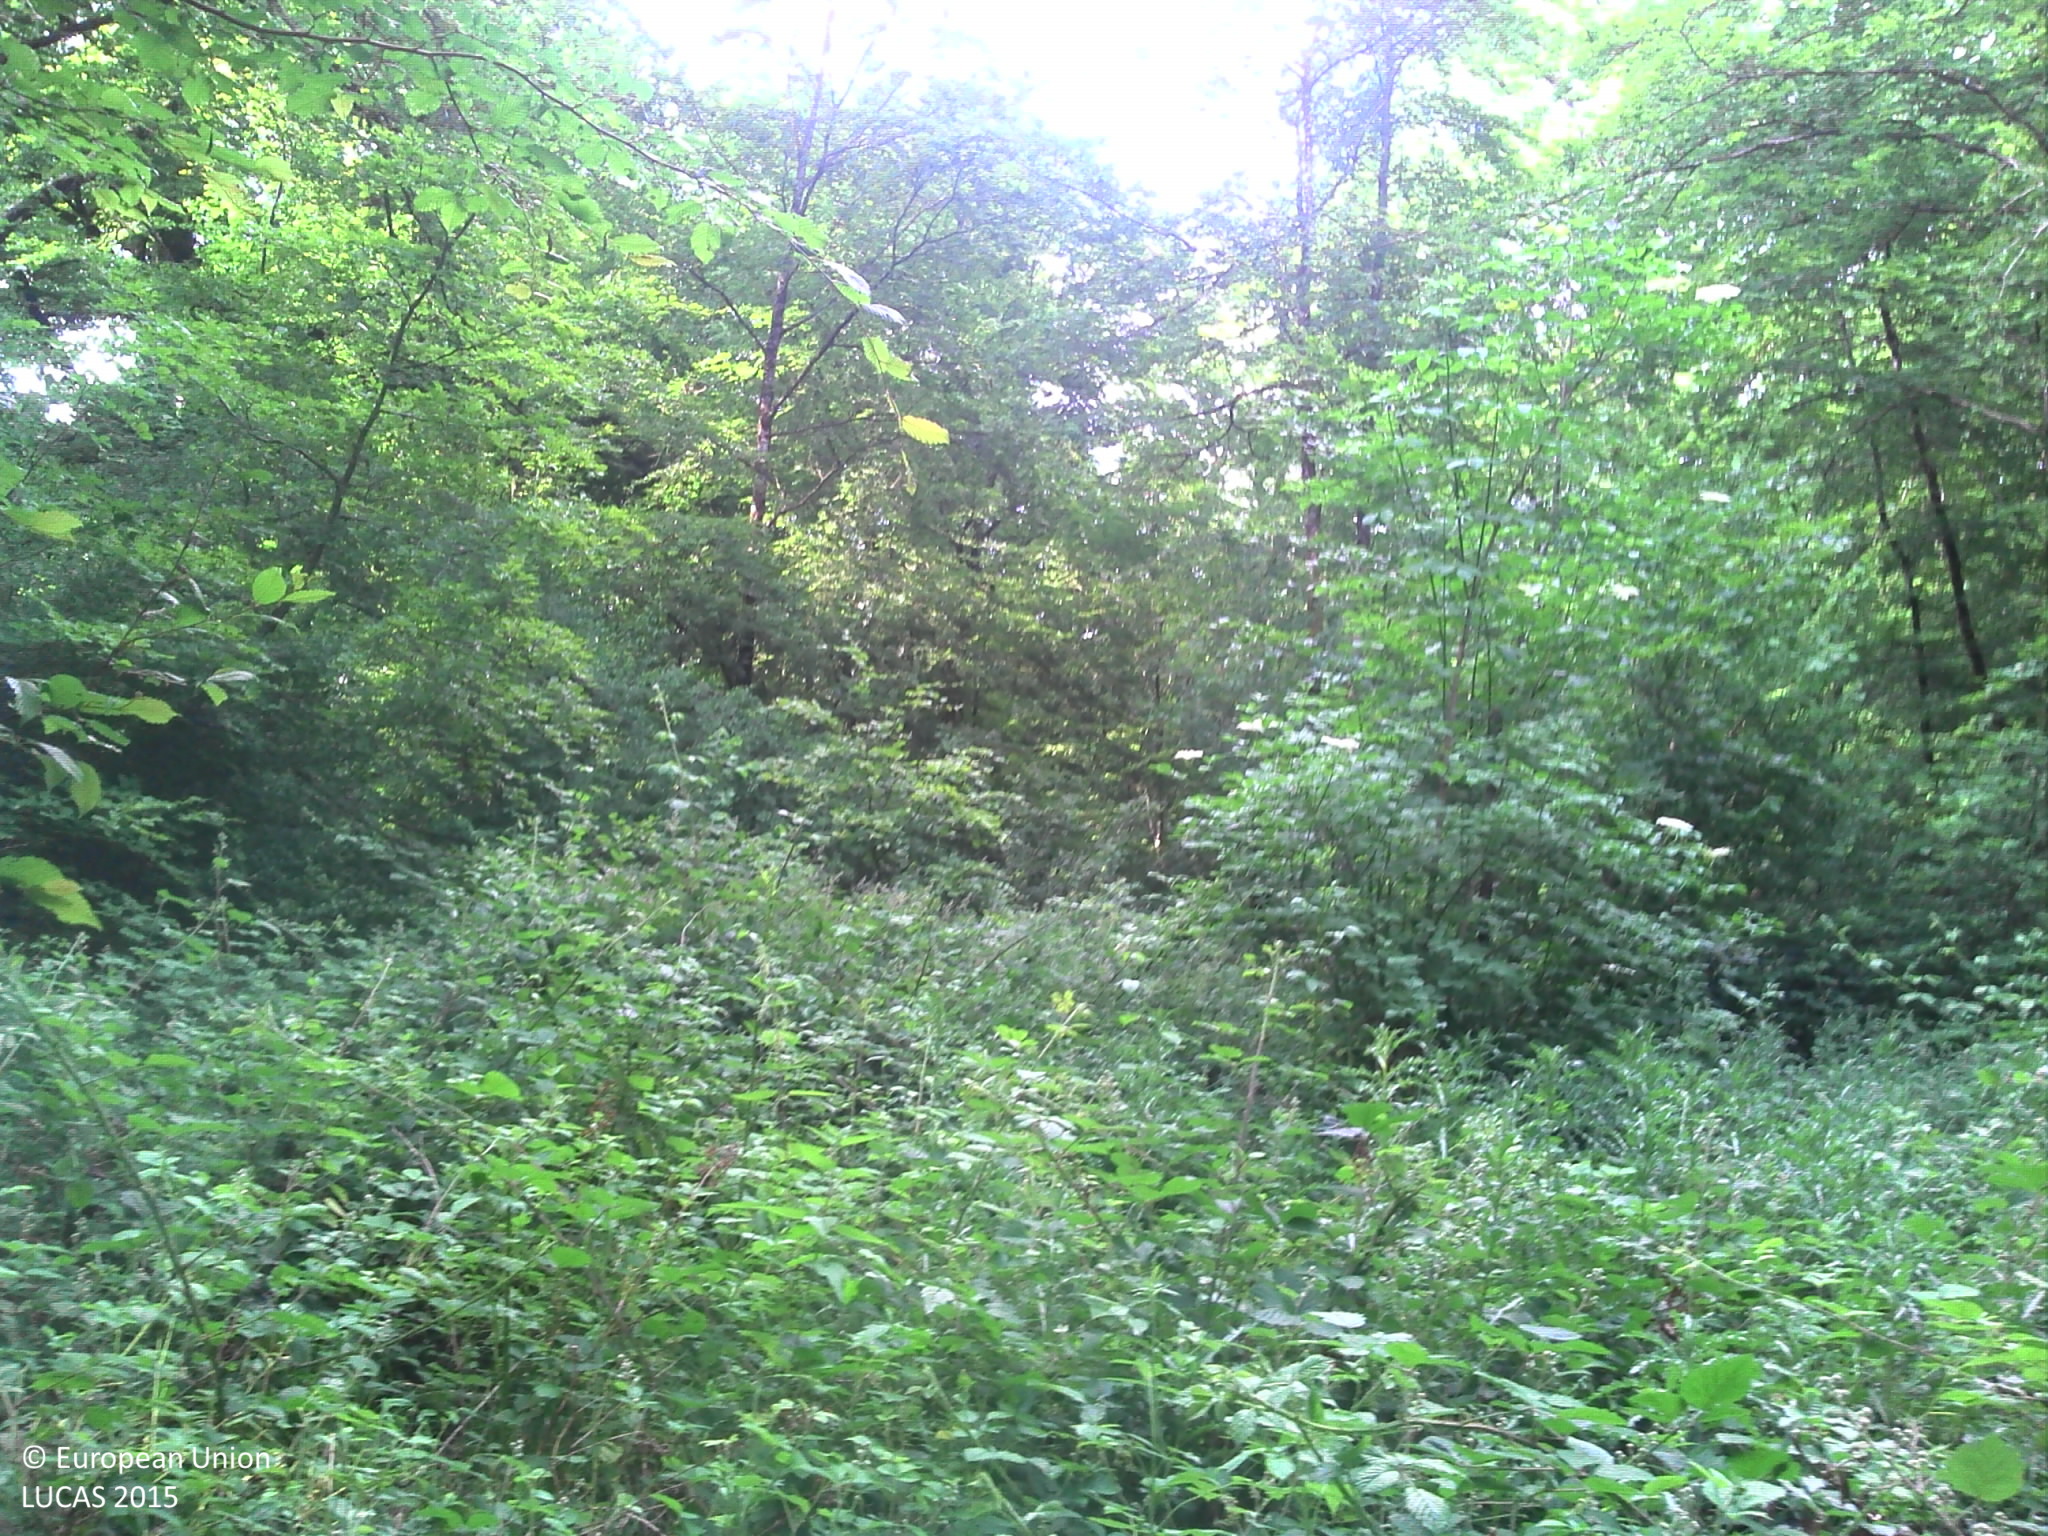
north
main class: Woodland
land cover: Broadleaved woodland
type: mesophytic deciduous forest
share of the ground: > 75 %
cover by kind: broadleaved forest trees 80 %, shrubs 10 %, herbaceous plants 10 %
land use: Forestry
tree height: > 5 m
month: June
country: FR
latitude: 48.3405
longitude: 4.9122
